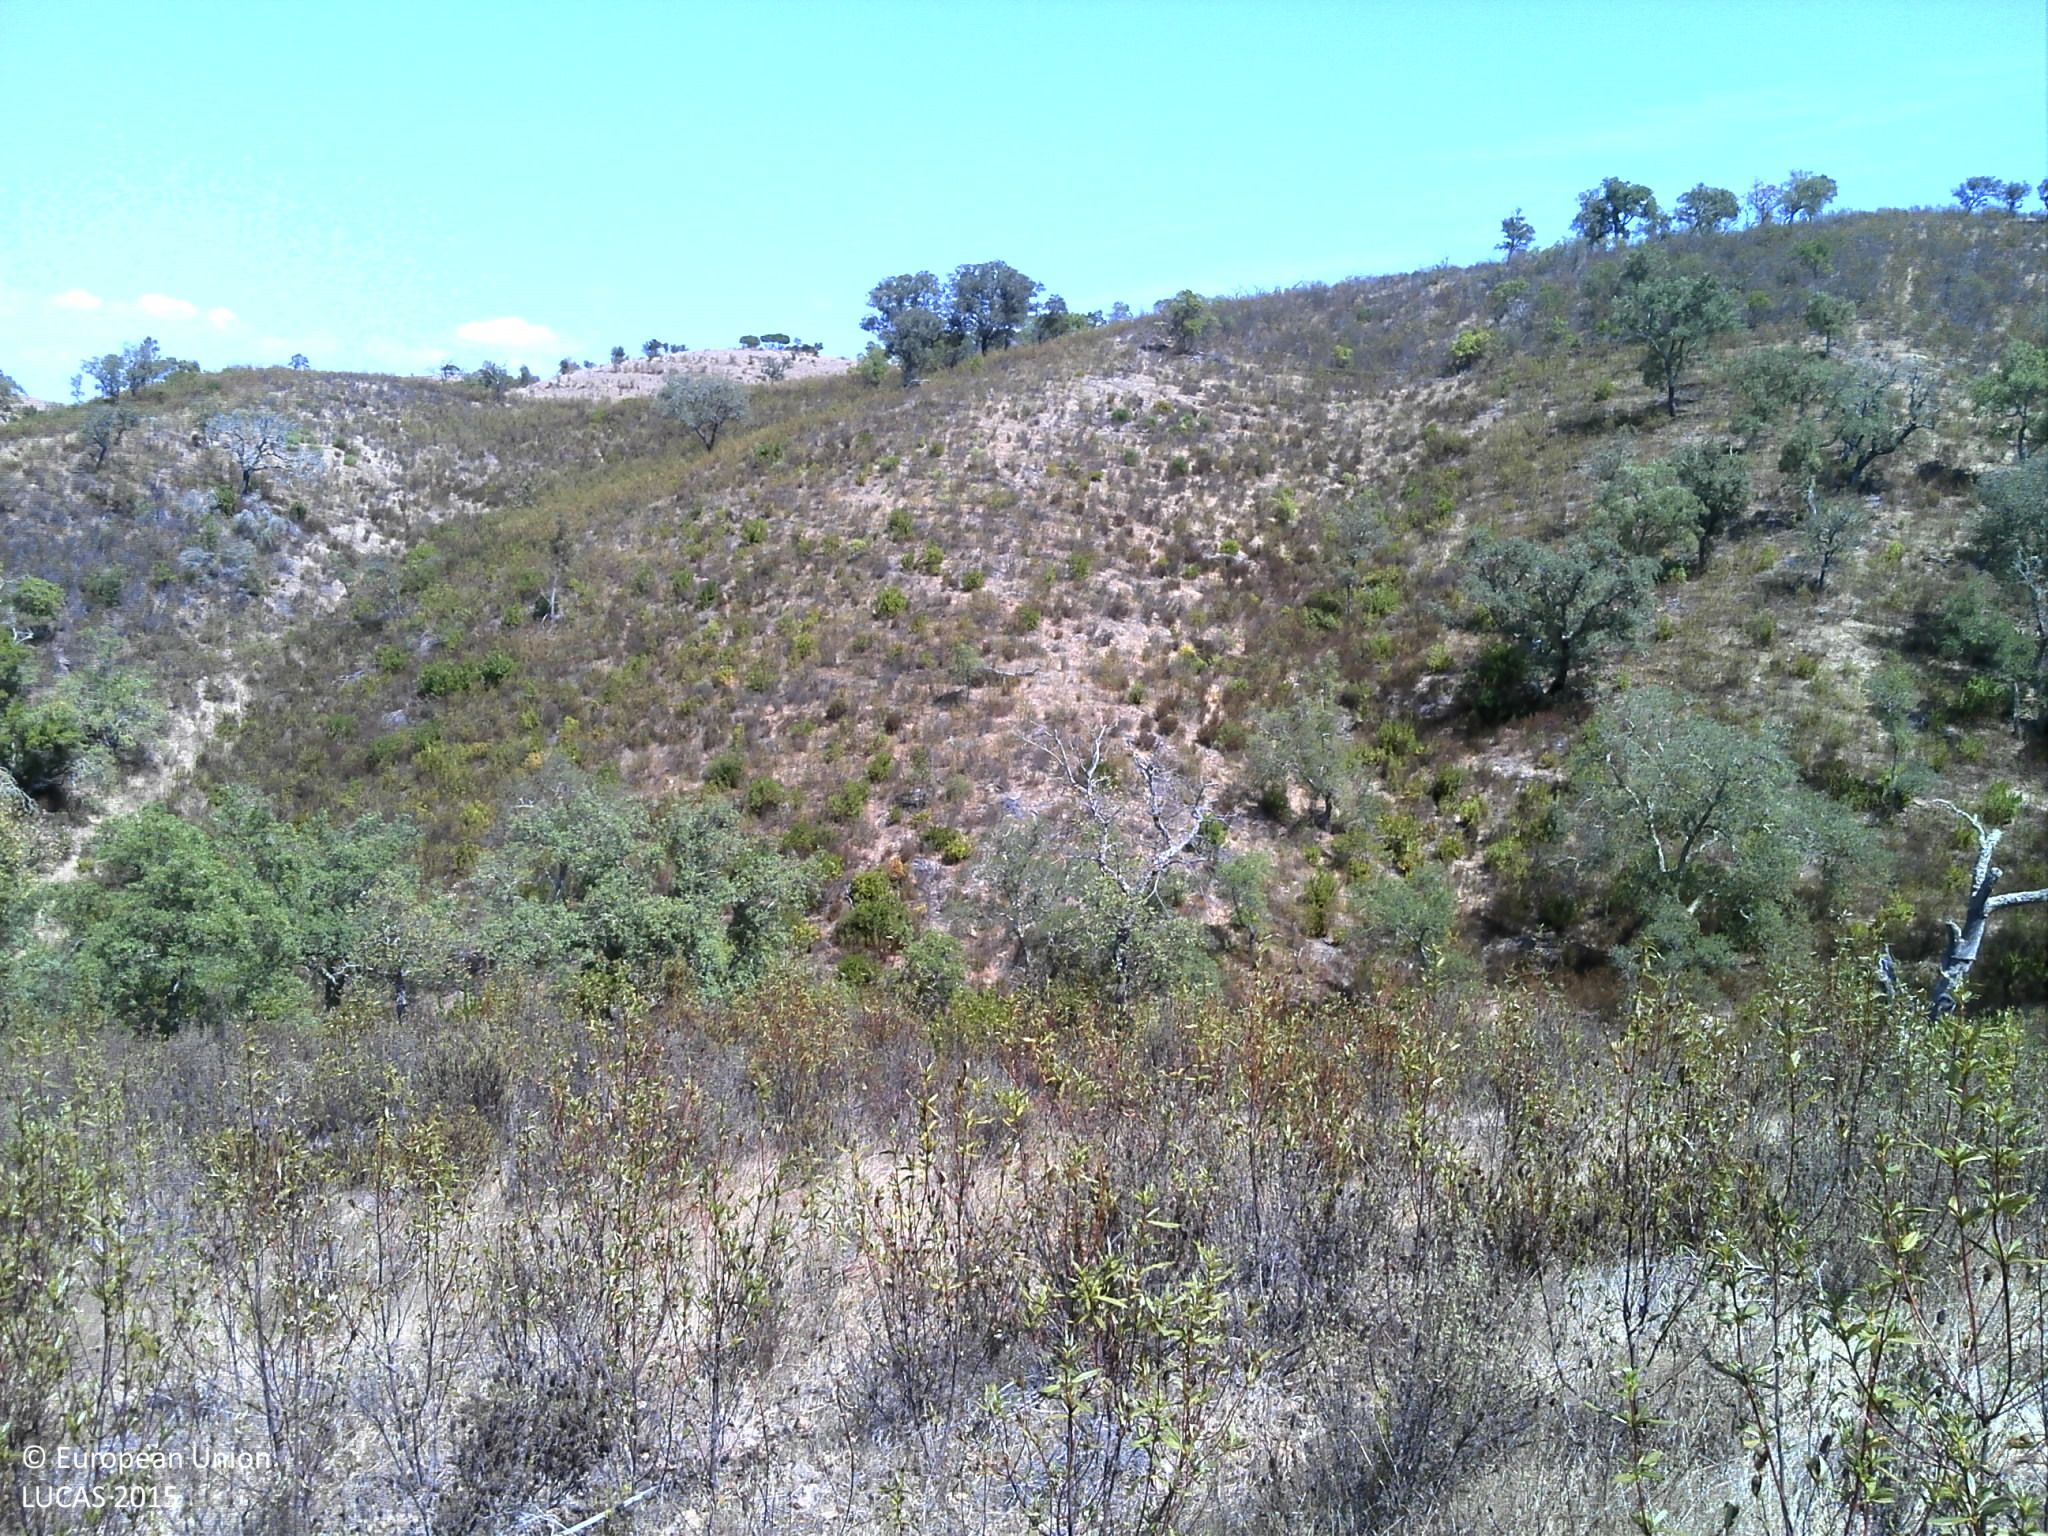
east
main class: Shrubland
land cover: Shrubland with sparse tree cover
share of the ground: 50 - 75 %
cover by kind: shrubs 60 %, unconsolidated bare surface 35 %, broadleaved forest trees 5 %
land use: Forestry
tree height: < 5 m
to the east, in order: Shrubland with sparse tree cover; Rivers and streams; Tracks; Broadleaved woodland; Tracks; Broadleaved woodland; Rivers and streams; Tracks; Broadleaved woodland; Shrubland without tree cover; Shrubland with sparse tree cover
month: September
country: PT
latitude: 37.4852
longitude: -8.2452
